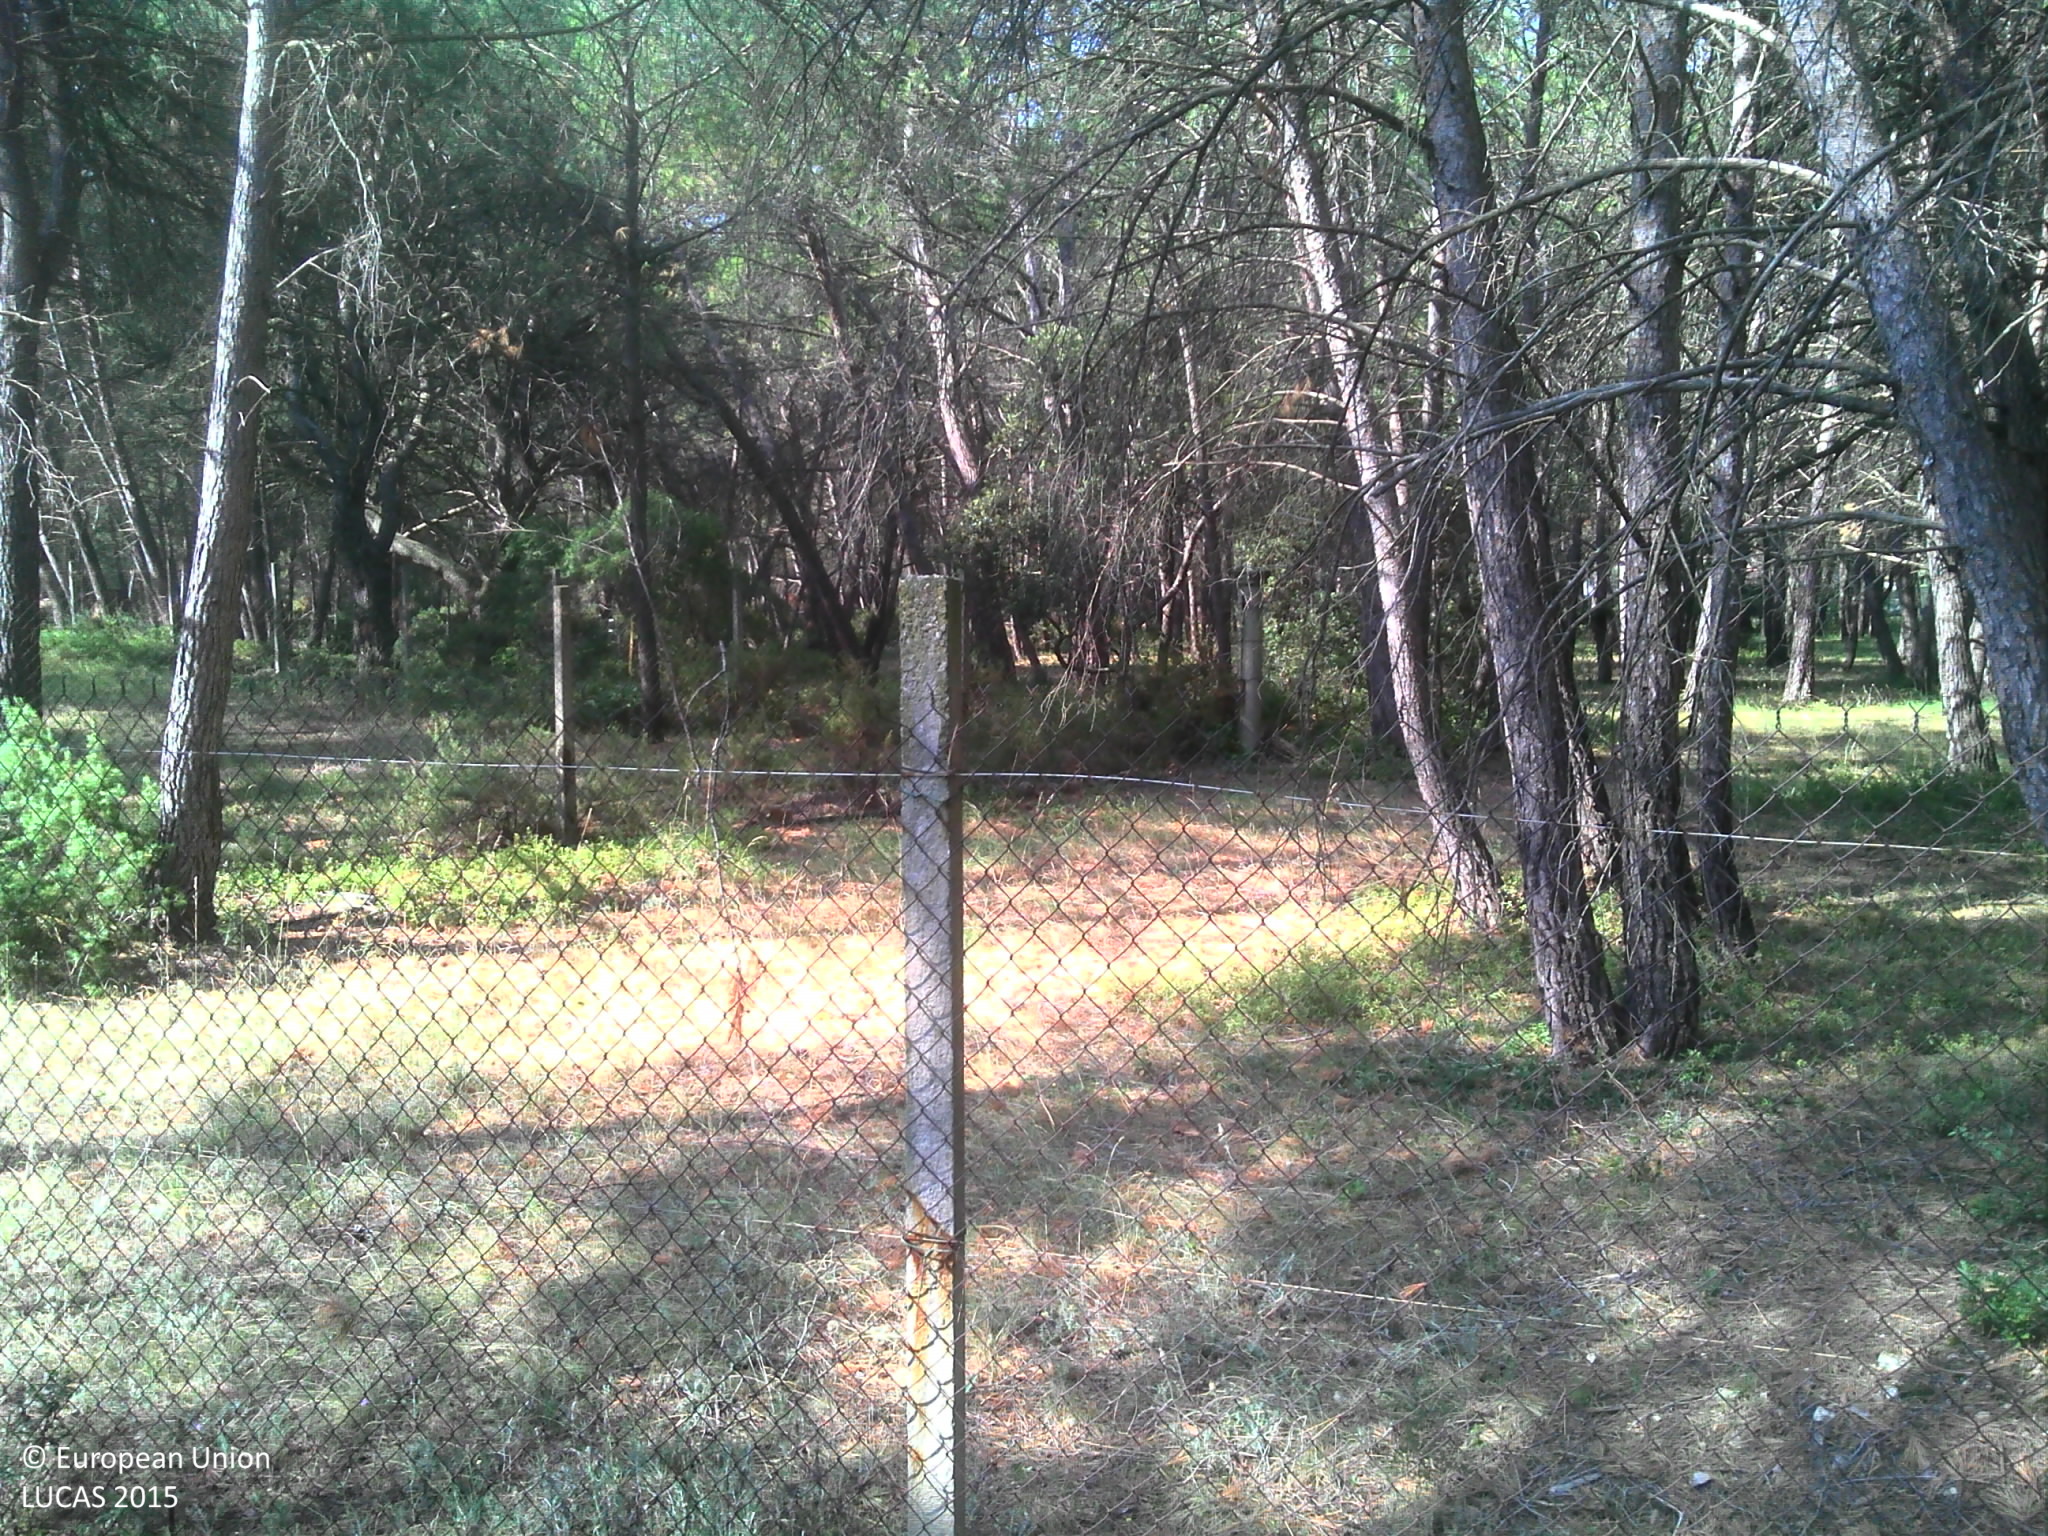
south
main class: Woodland
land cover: Pine dominated coniferous woodland
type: coniferous forest of the mediterranean region
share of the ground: > 75 %
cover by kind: coniferous forest trees 60 %, herbaceous plants 20 %, shrubs 15 %, broadleaved forest trees 5 %
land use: Residential
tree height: > 5 m
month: July
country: FR
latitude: 43.6281
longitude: 5.2627
